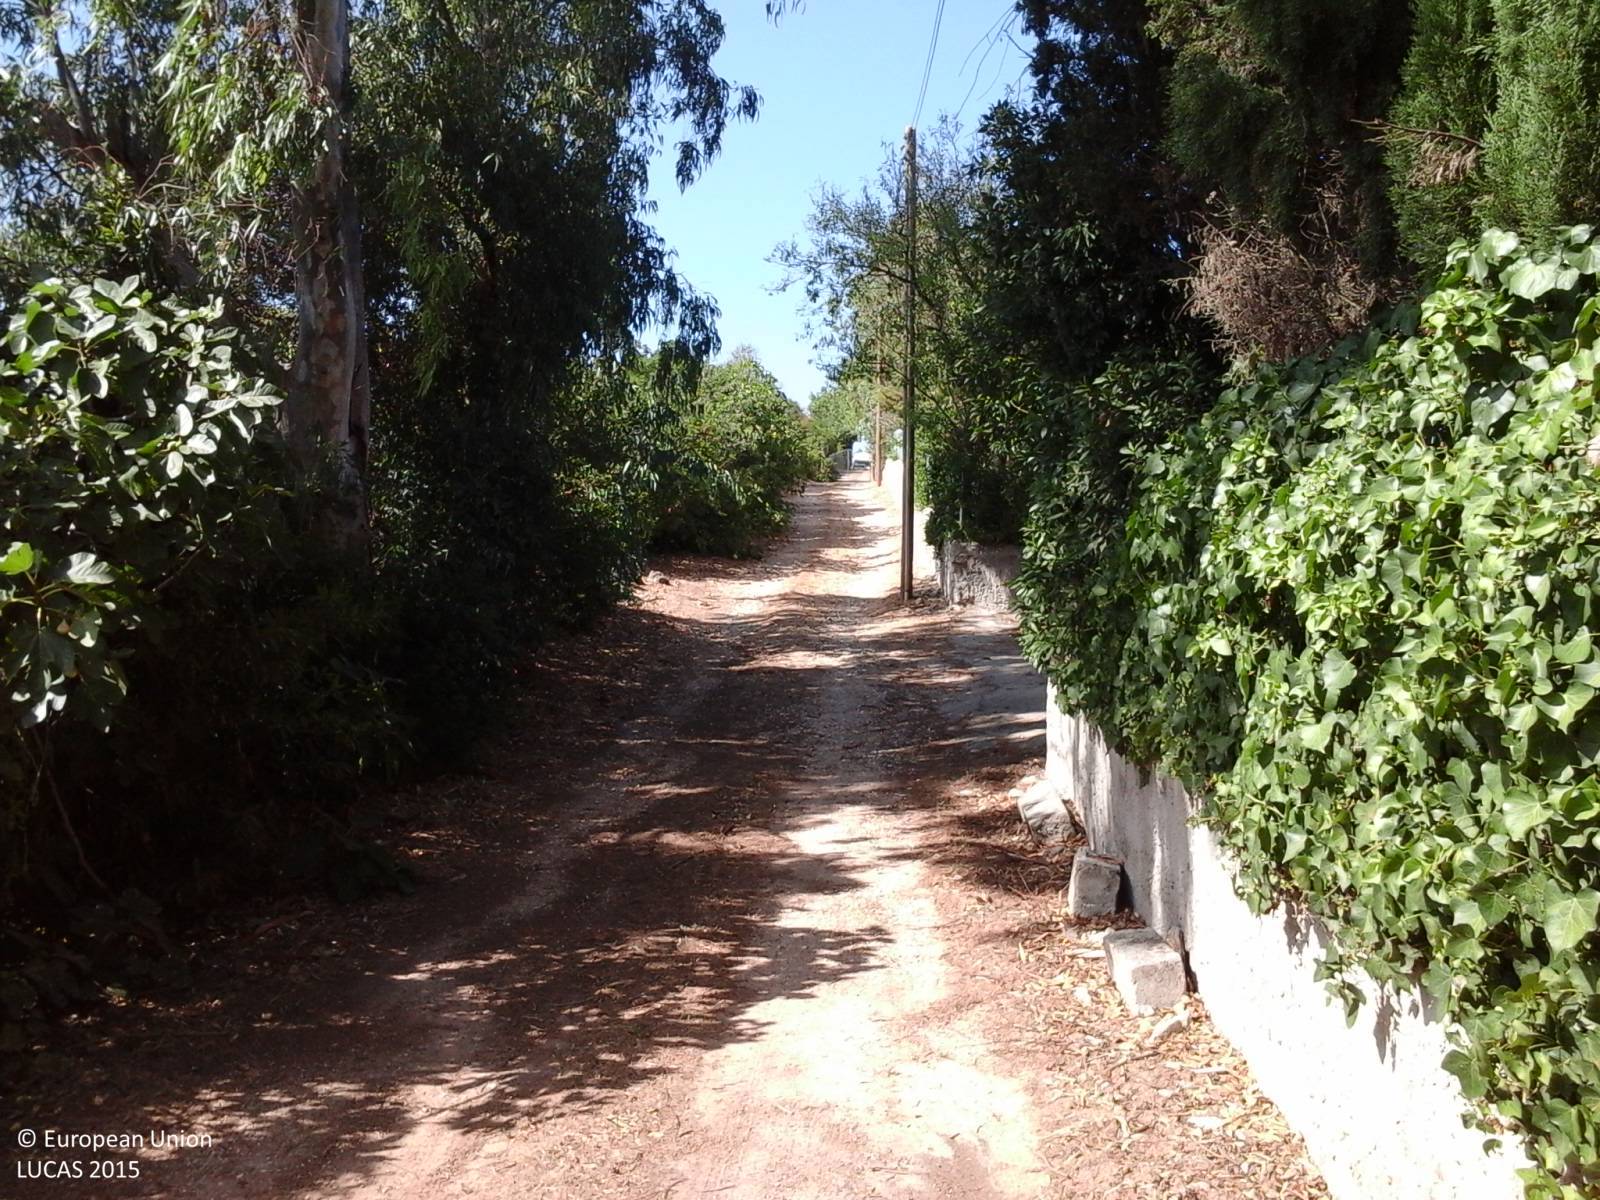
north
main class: Cropland
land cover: Other fruit trees and berries
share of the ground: 25 - 50 %
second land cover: Grassland without tree/shrub cover
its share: 10 - 25 %
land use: Kitchen garden
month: May
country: IT
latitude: 40.7258
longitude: 8.4564
